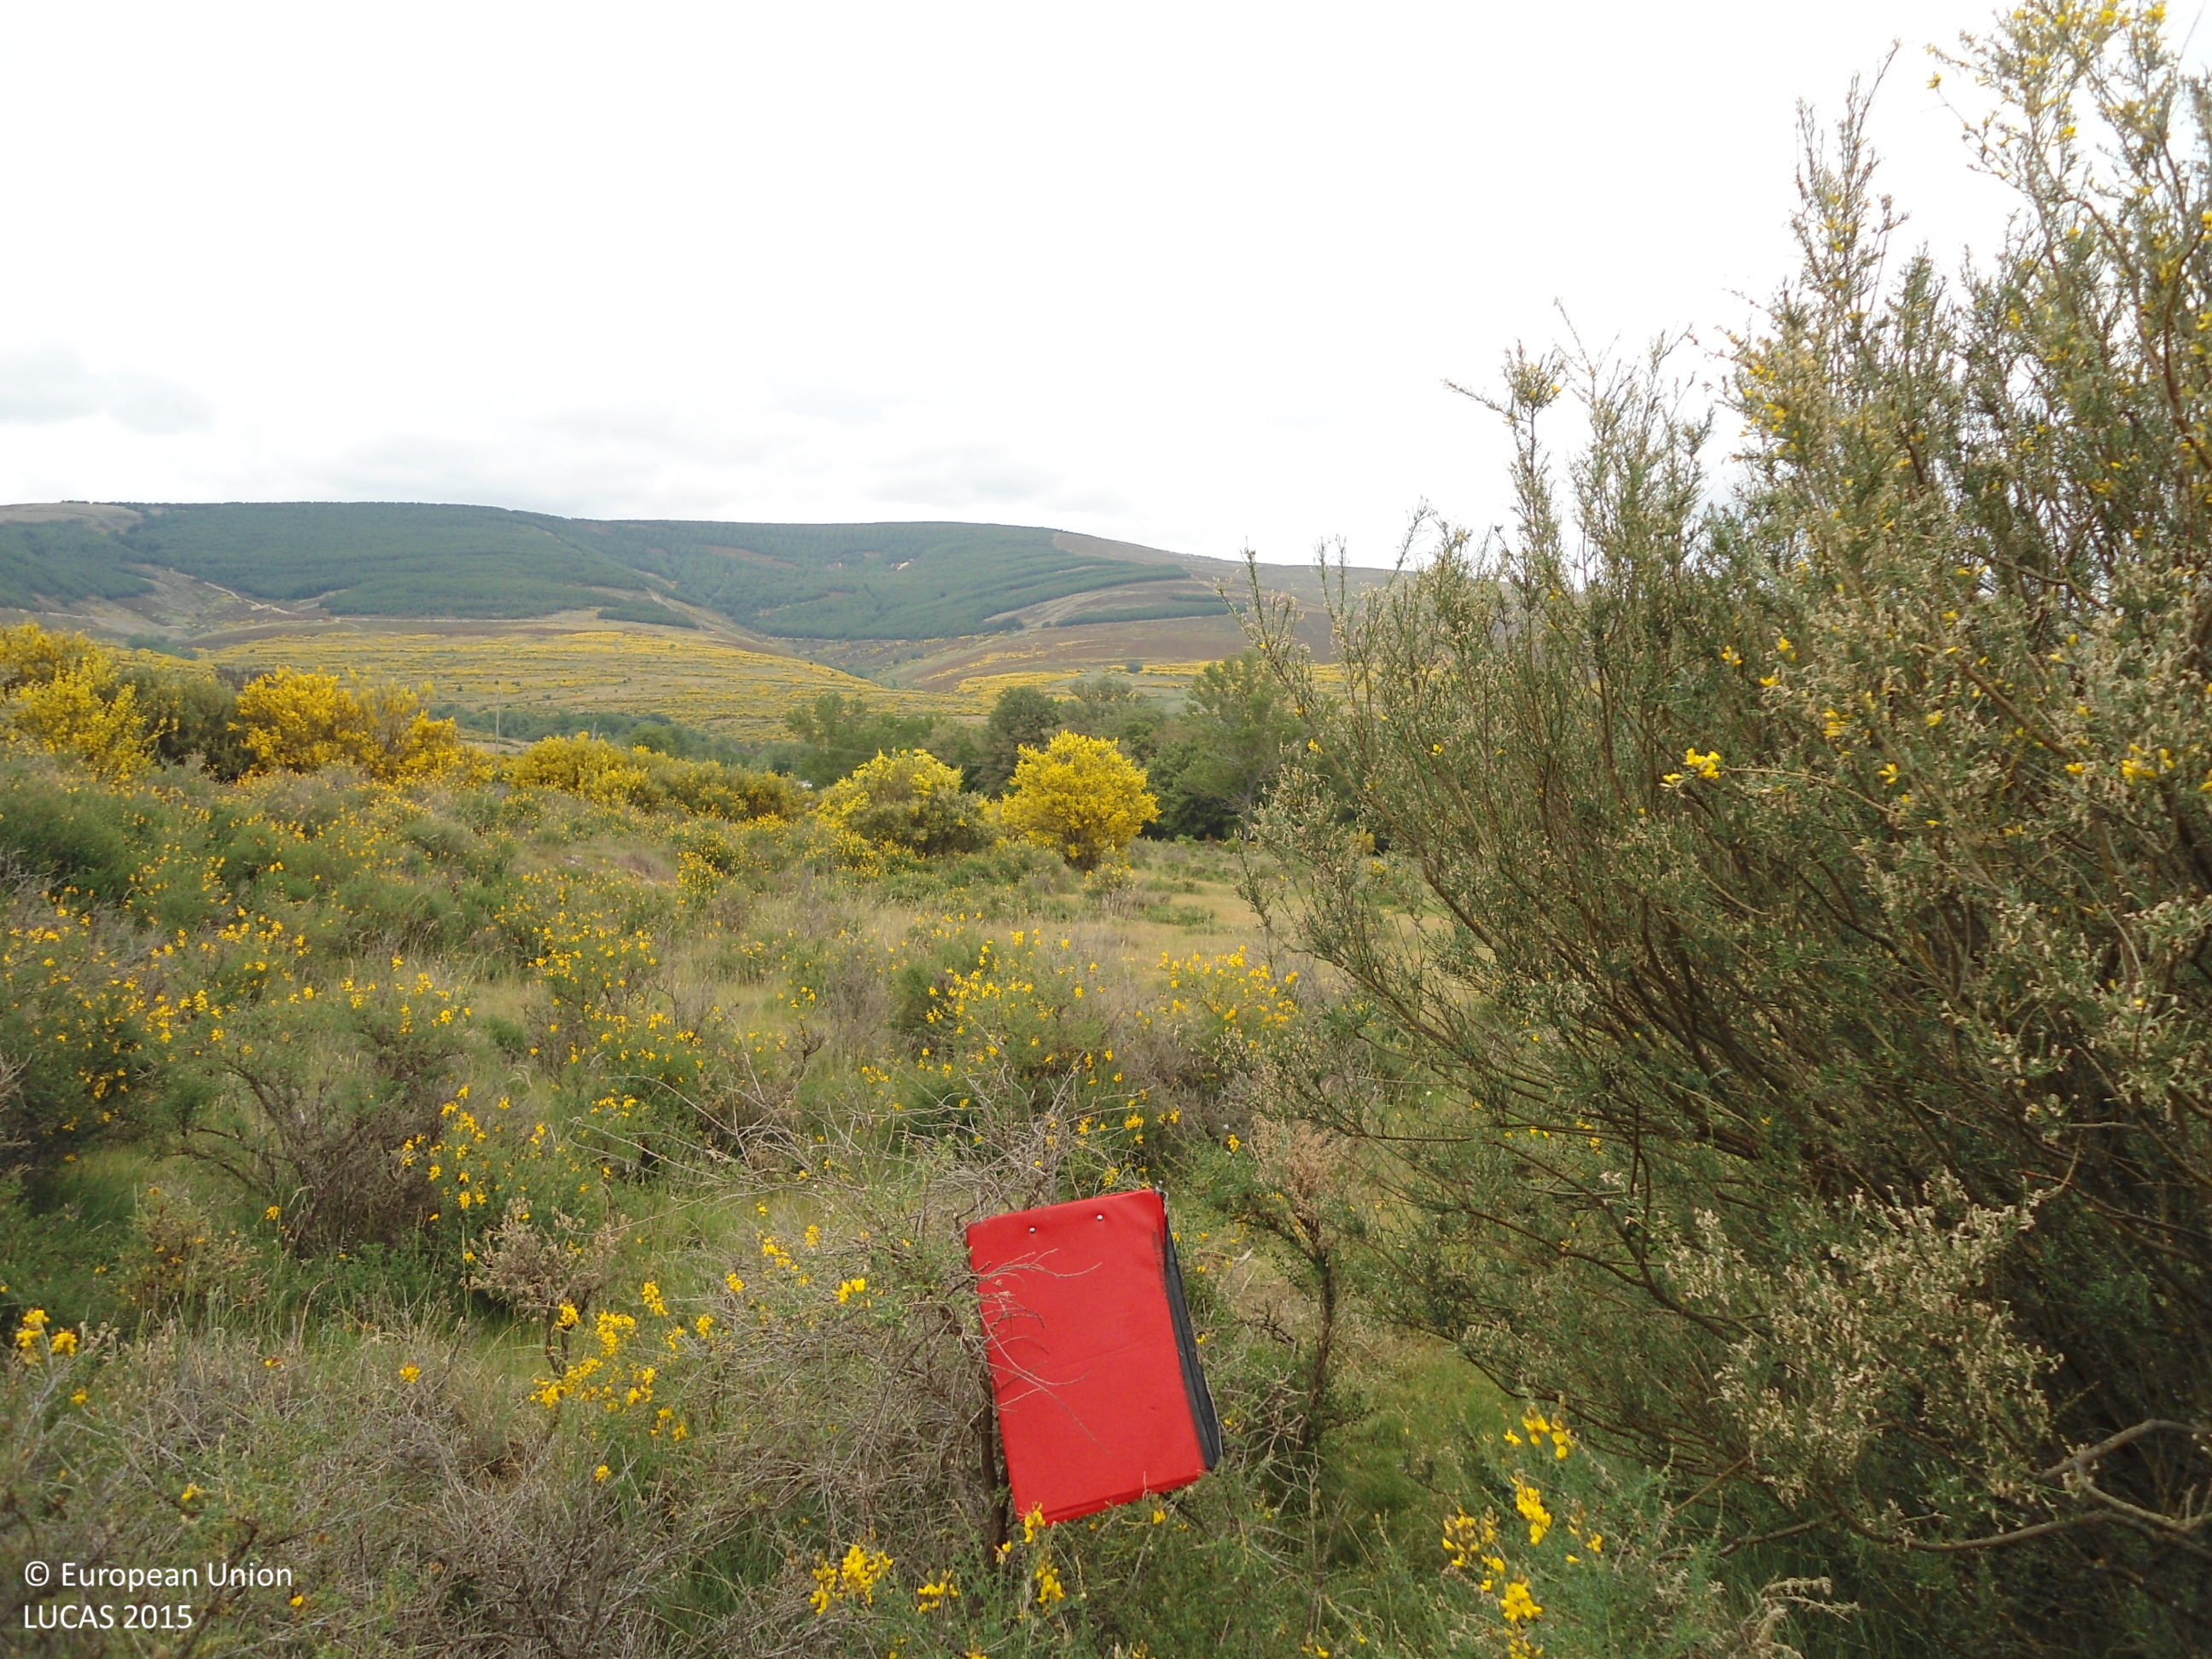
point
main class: Shrubland
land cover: Shrubland without tree cover
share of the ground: > 75 %
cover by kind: shrubs 75 %, herbaceous plants 25 %
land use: Agriculture (excluding fallow land and kitchen gardens)
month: June
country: ES
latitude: 42.2563
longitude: -6.4397
